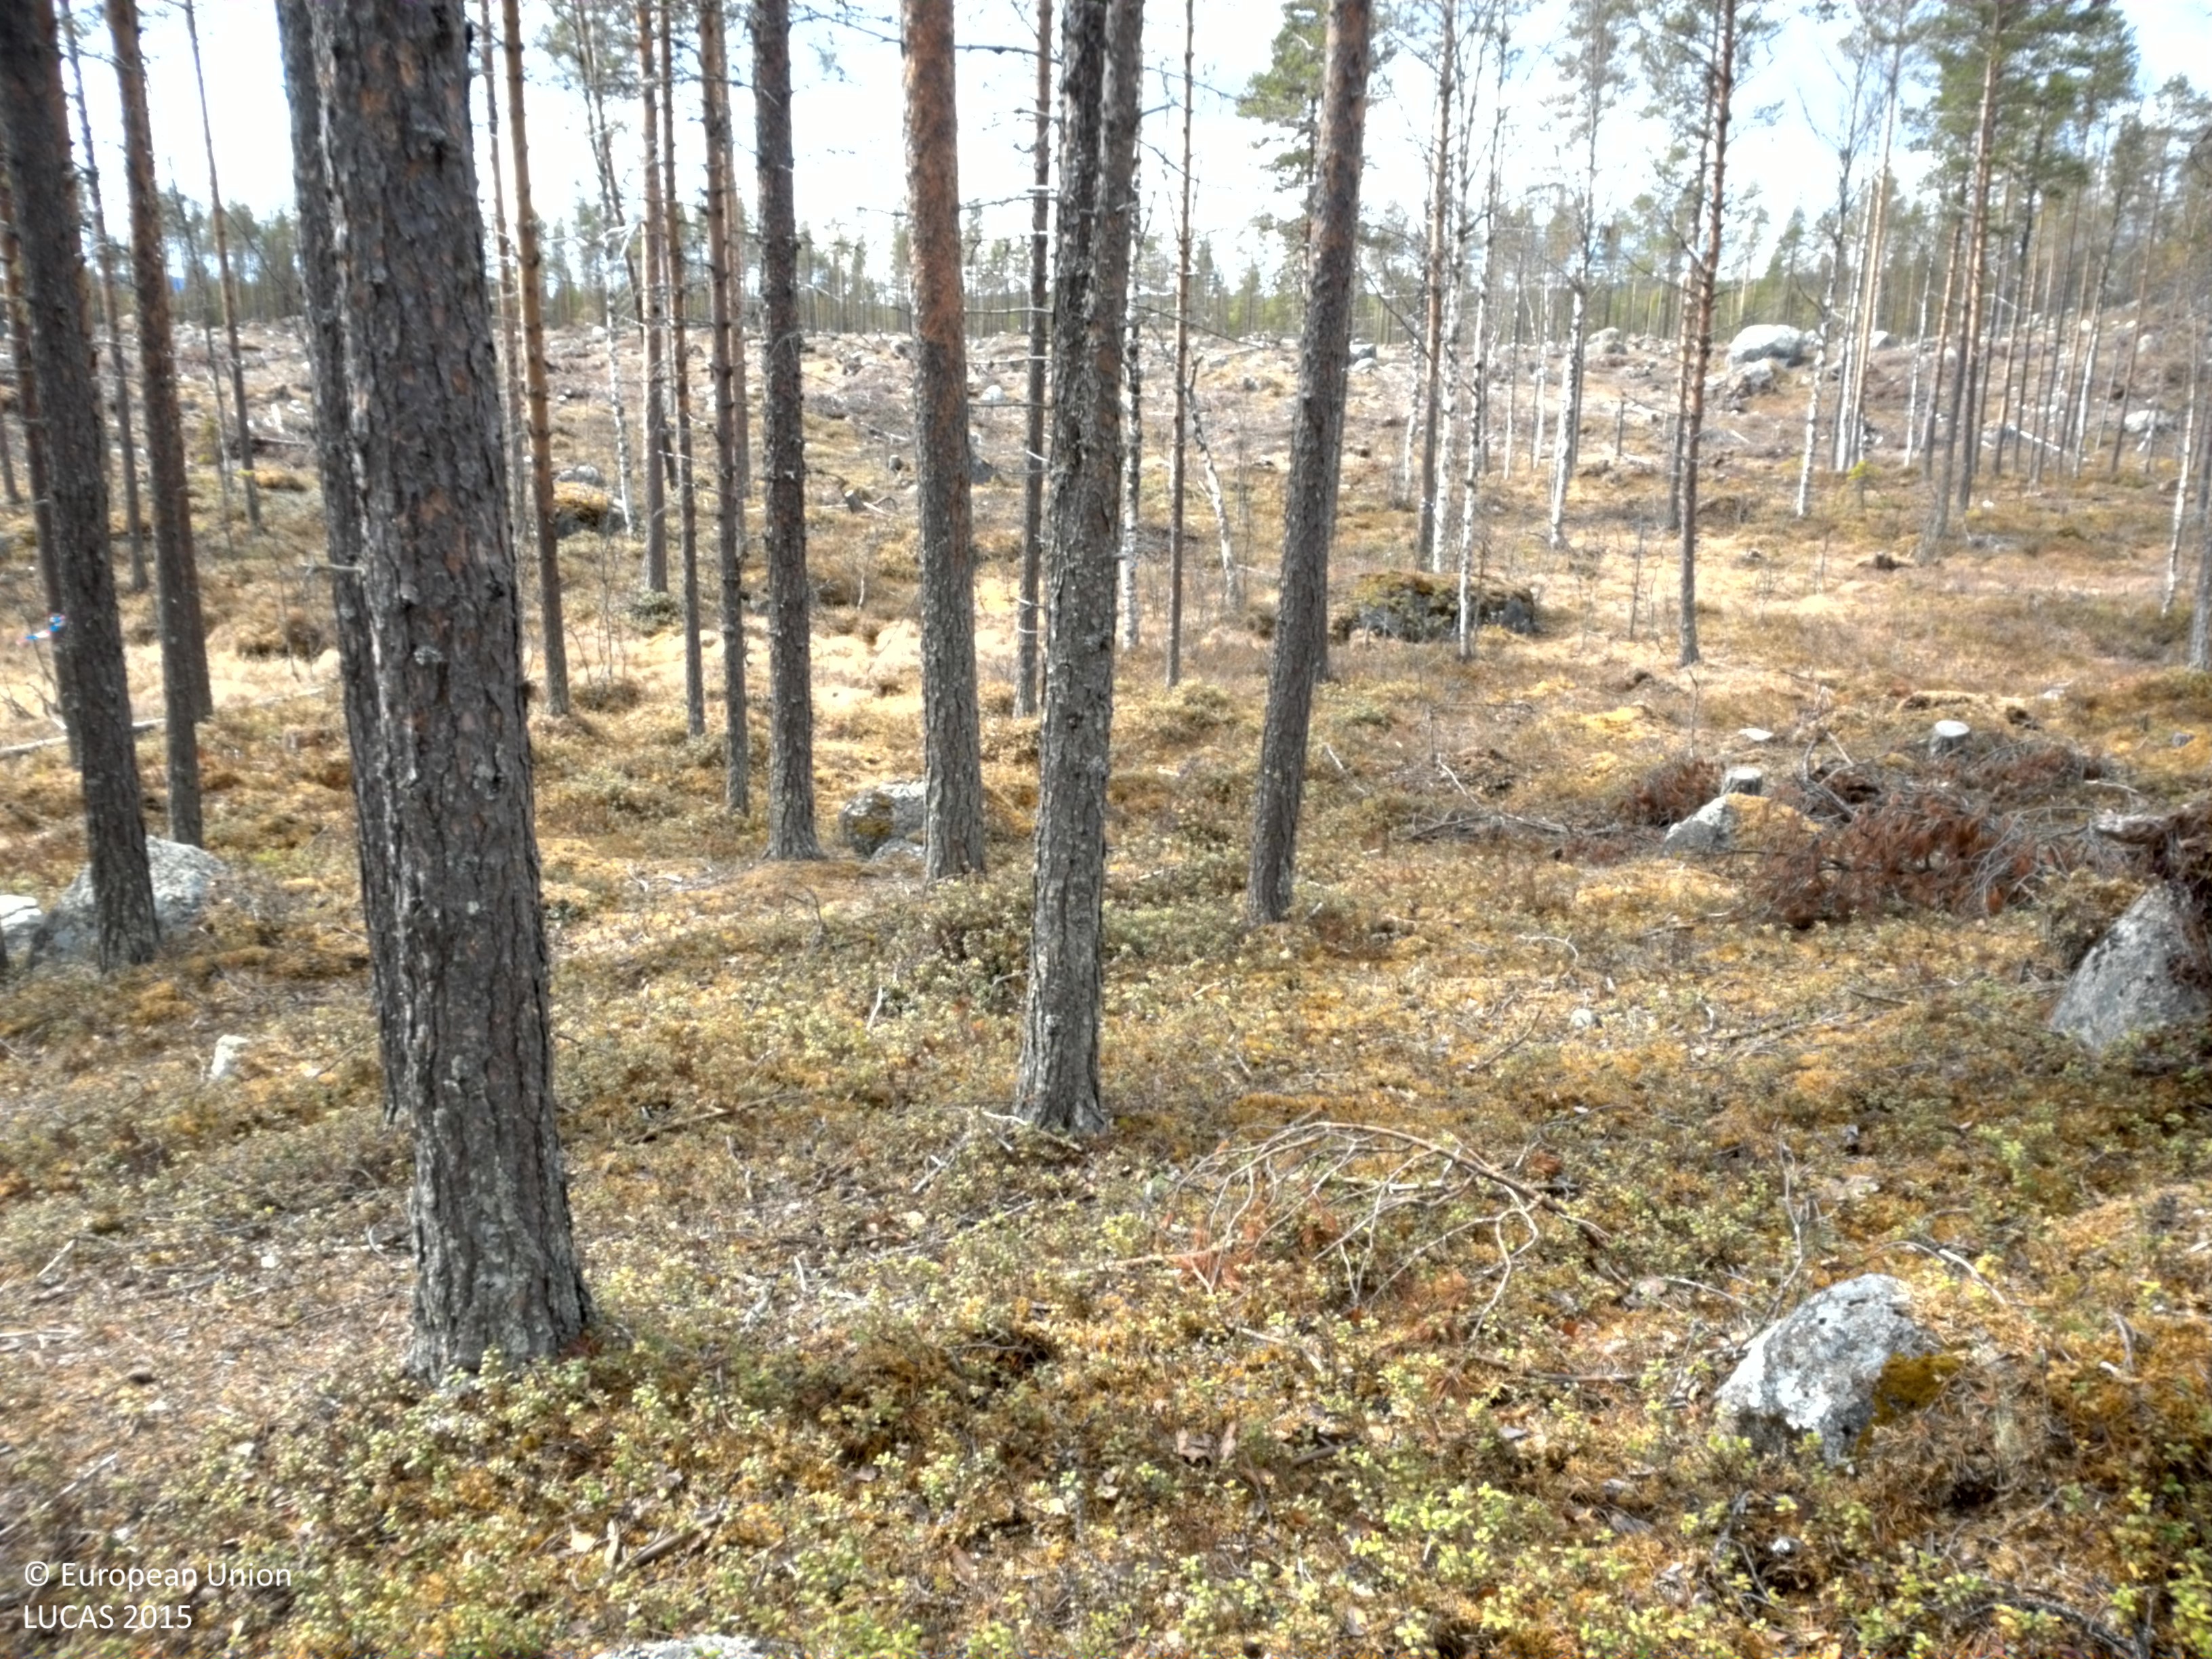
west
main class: Woodland
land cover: Pine dominated coniferous woodland
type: boreal forest
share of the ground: 10 - 25 %
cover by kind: herbaceous plants 75 %, coniferous forest trees 15 %, broadleaved forest trees 5 %, lichens and mosses 5 %
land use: Forestry
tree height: > 5 m
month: May
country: SE
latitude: 64.1732
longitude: 18.0965
